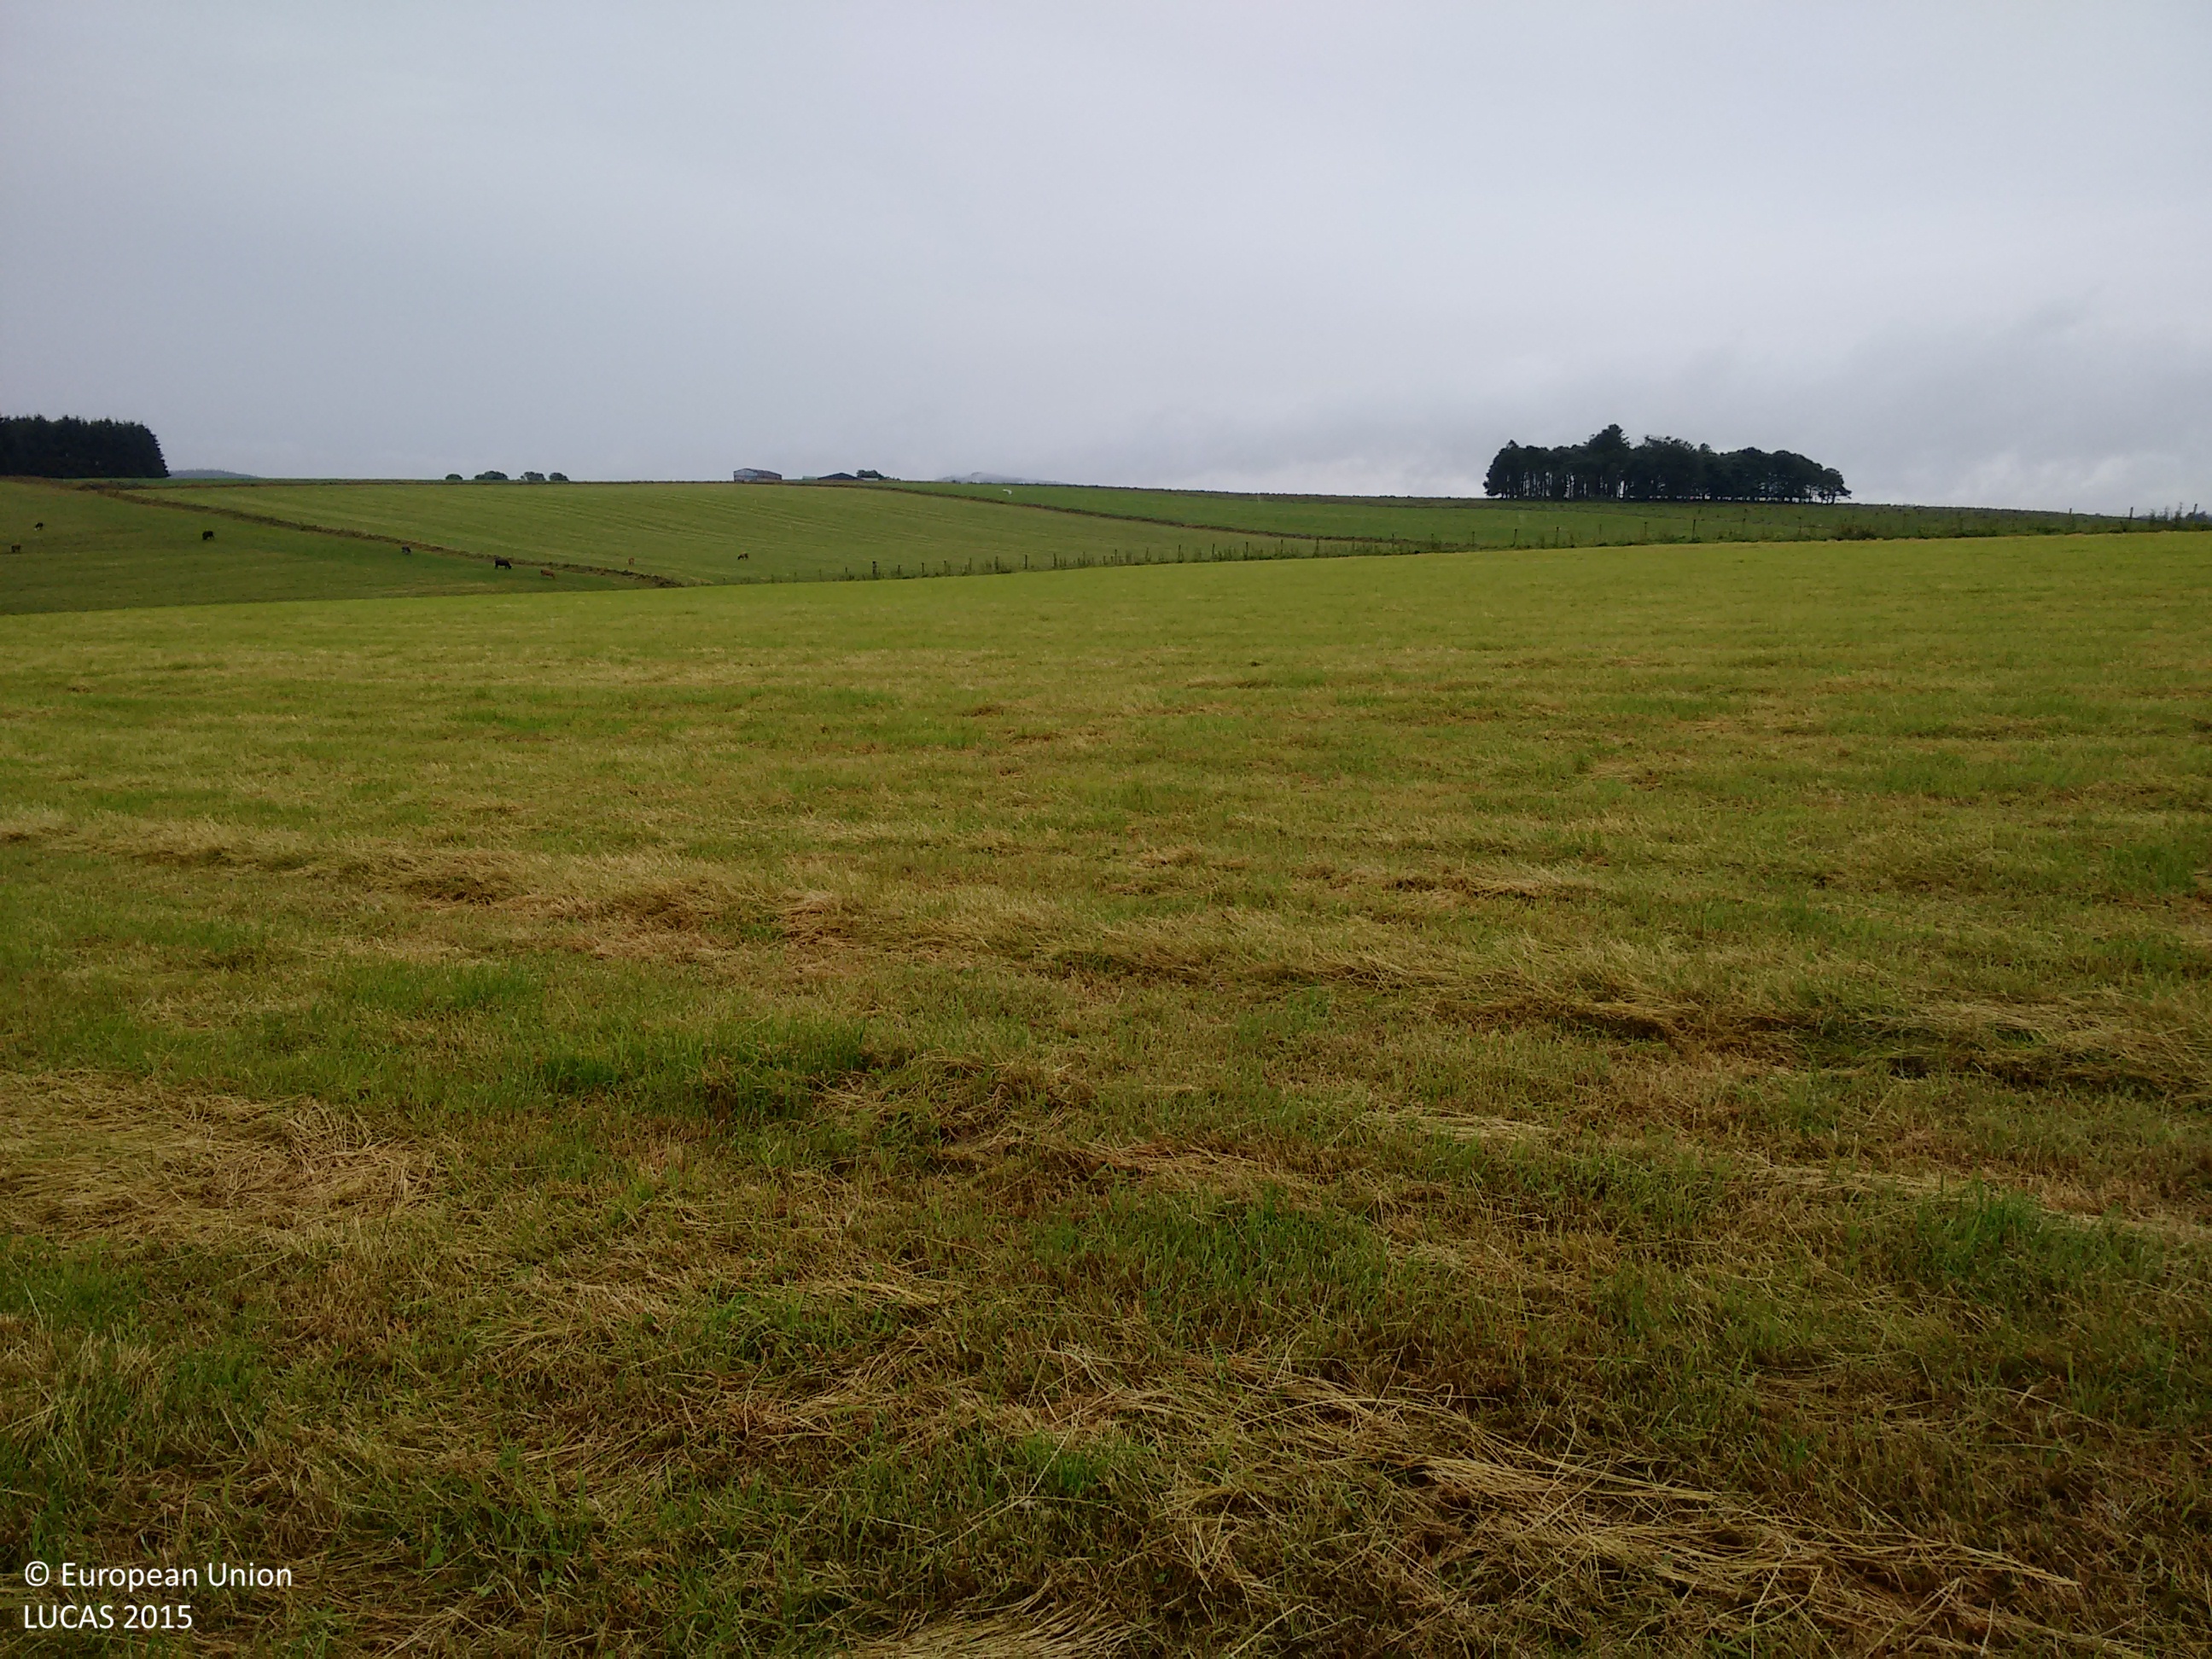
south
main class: Cropland
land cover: Temporary grasslands
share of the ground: > 75 %
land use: Agriculture (excluding fallow land and kitchen gardens)
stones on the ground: < 10 %
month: August
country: GB
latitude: 57.5279
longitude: -2.8336
